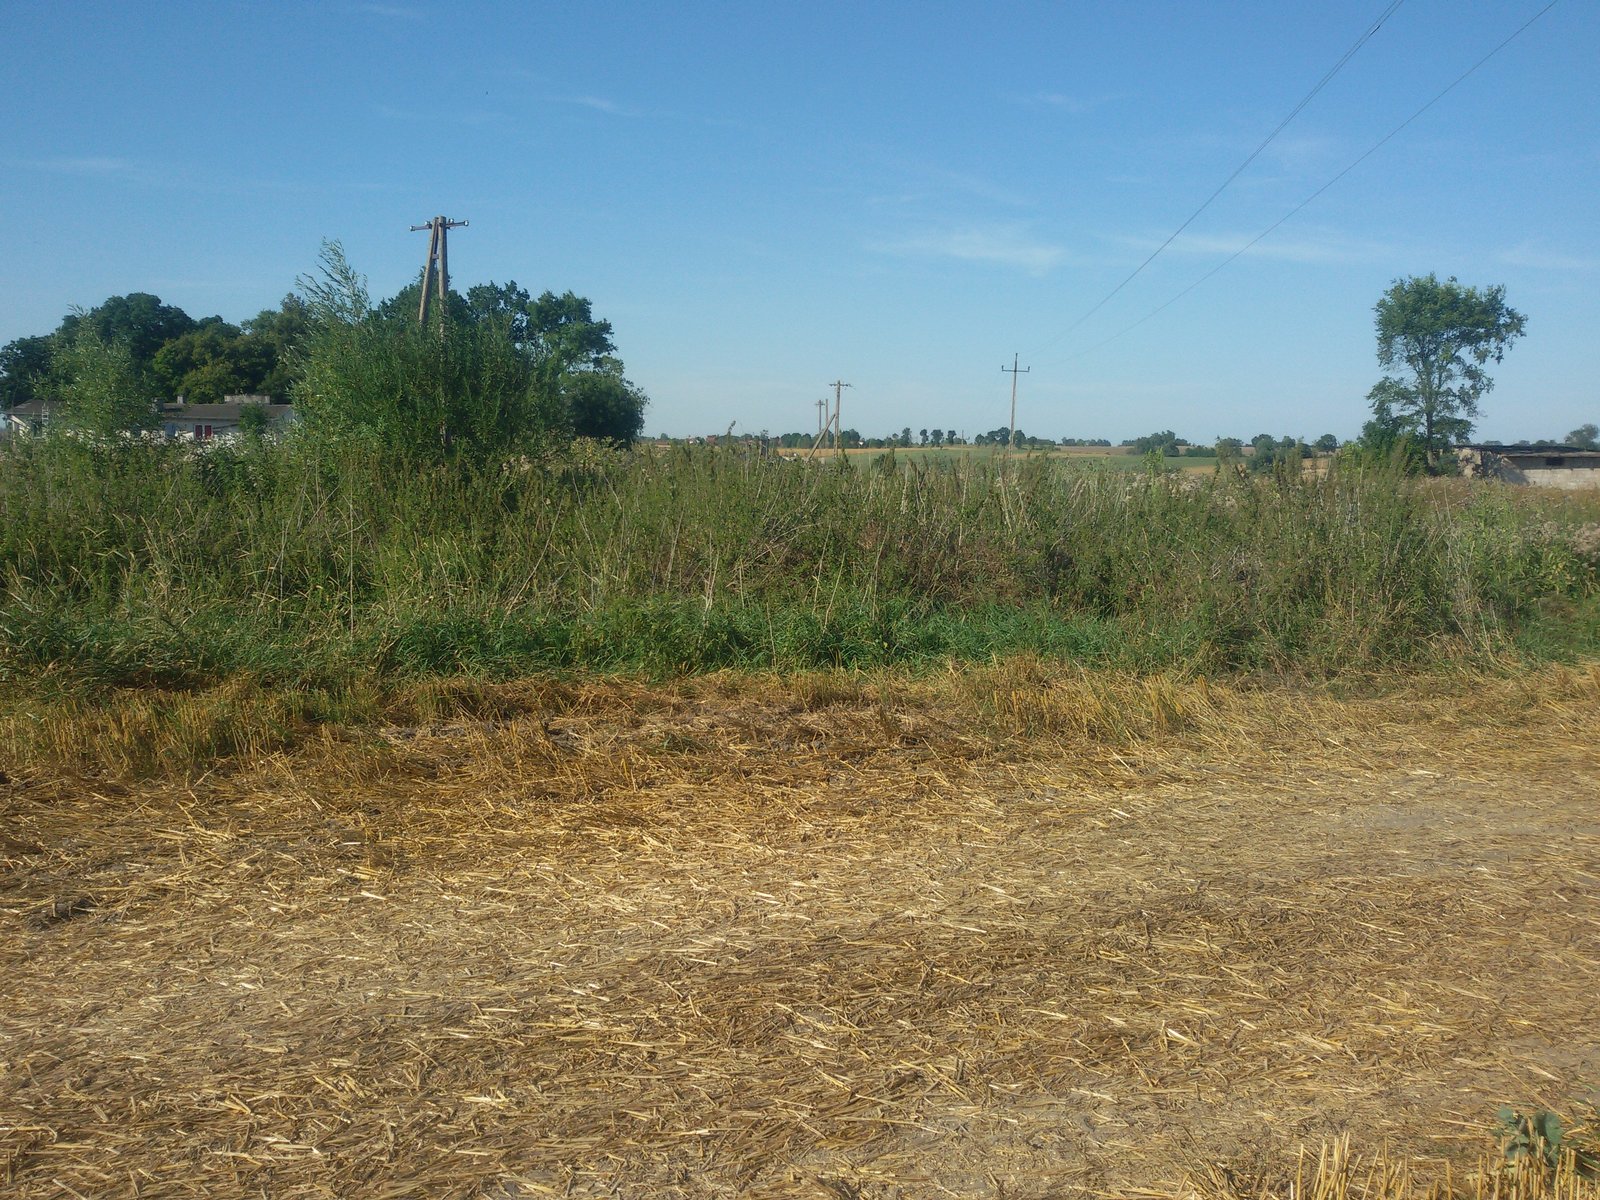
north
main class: Cropland
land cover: Common wheat
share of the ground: > 75 %
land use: Agriculture (excluding fallow land and kitchen gardens)
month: August
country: PL
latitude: 54.0895
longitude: 21.2833
